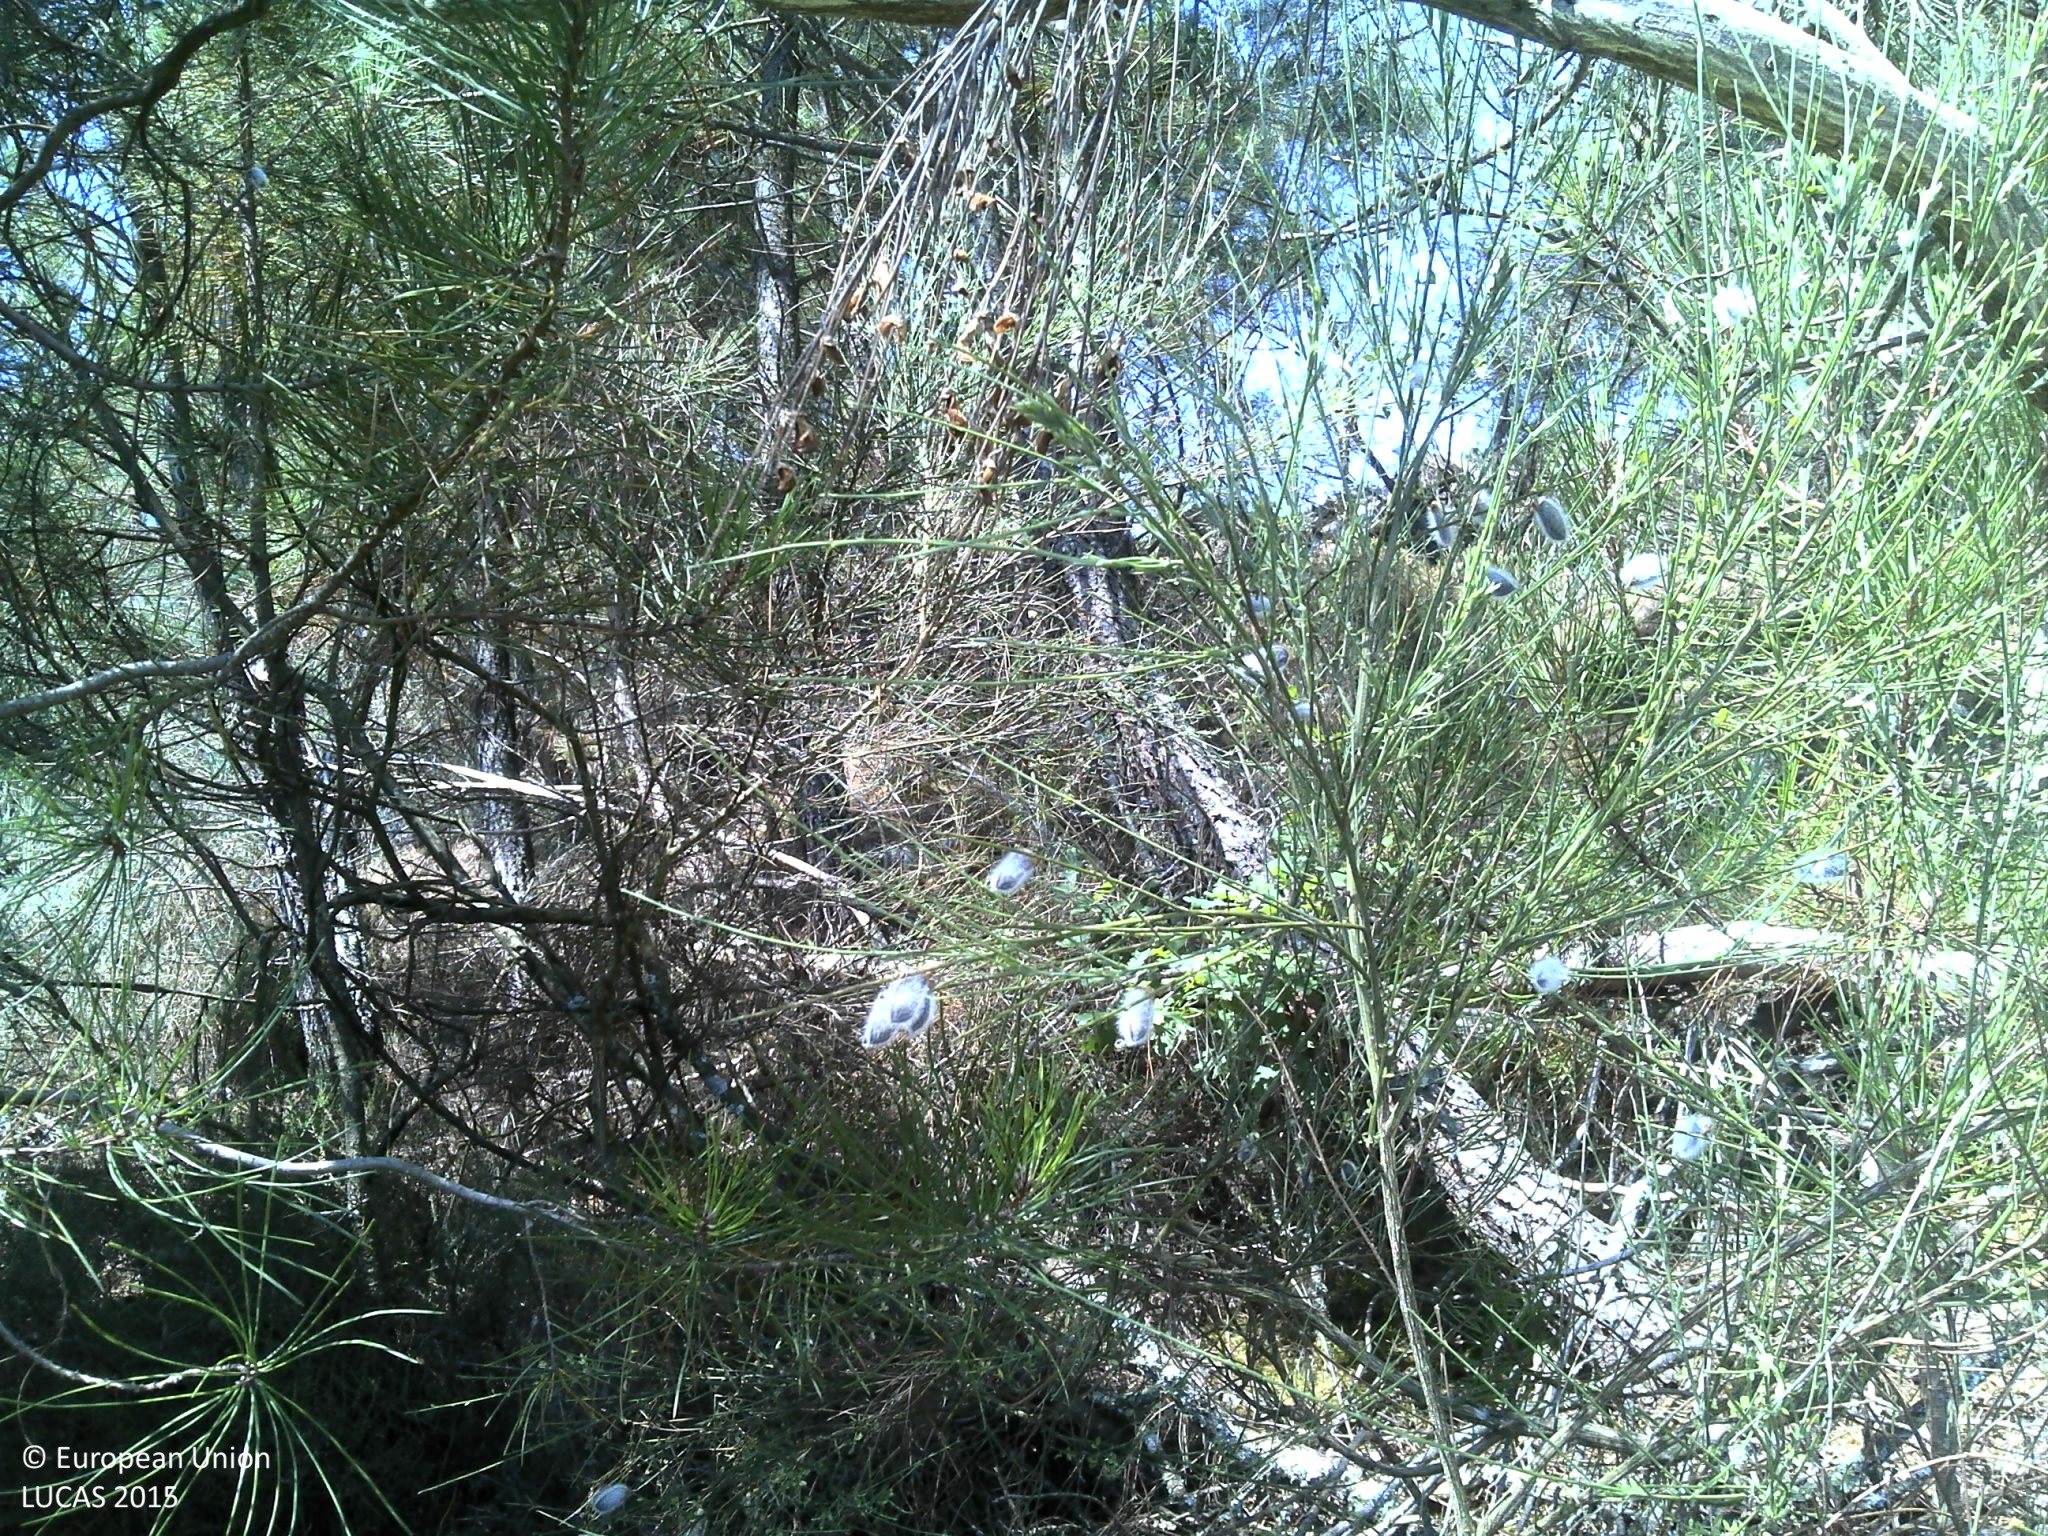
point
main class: Woodland
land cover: Pine dominated coniferous woodland
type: coniferous forest of the mediterranean region
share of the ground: 50 - 75 %
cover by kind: coniferous forest trees 65 %, shrubs 30 %, unconsolidated bare surface 5 %
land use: Semi-natural and natural areas not in use
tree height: > 5 m
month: July
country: PT
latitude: 41.5523
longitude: -7.8453
